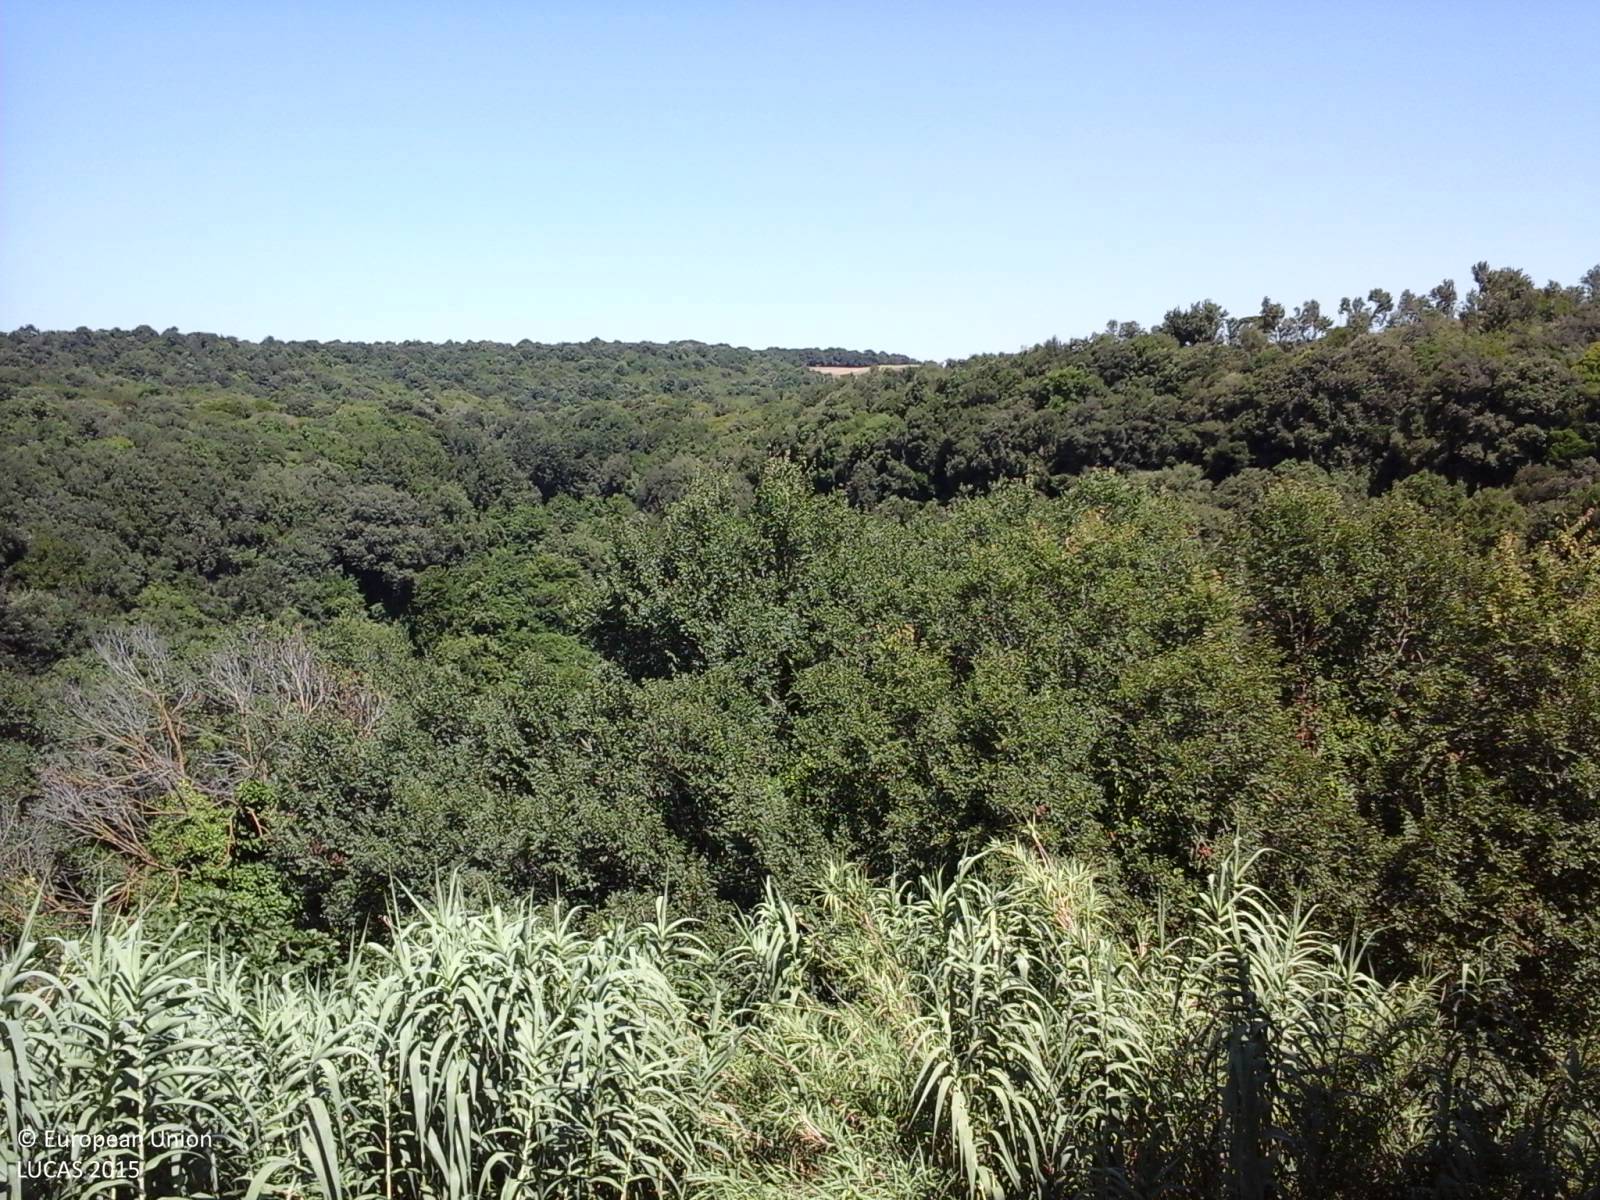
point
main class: Woodland
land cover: Broadleaved woodland
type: thermophilous deciduous forest
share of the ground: > 75 %
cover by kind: broadleaved forest trees 100 %
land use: Forestry
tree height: > 5 m
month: August
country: IT
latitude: 41.9986
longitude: 12.1530
